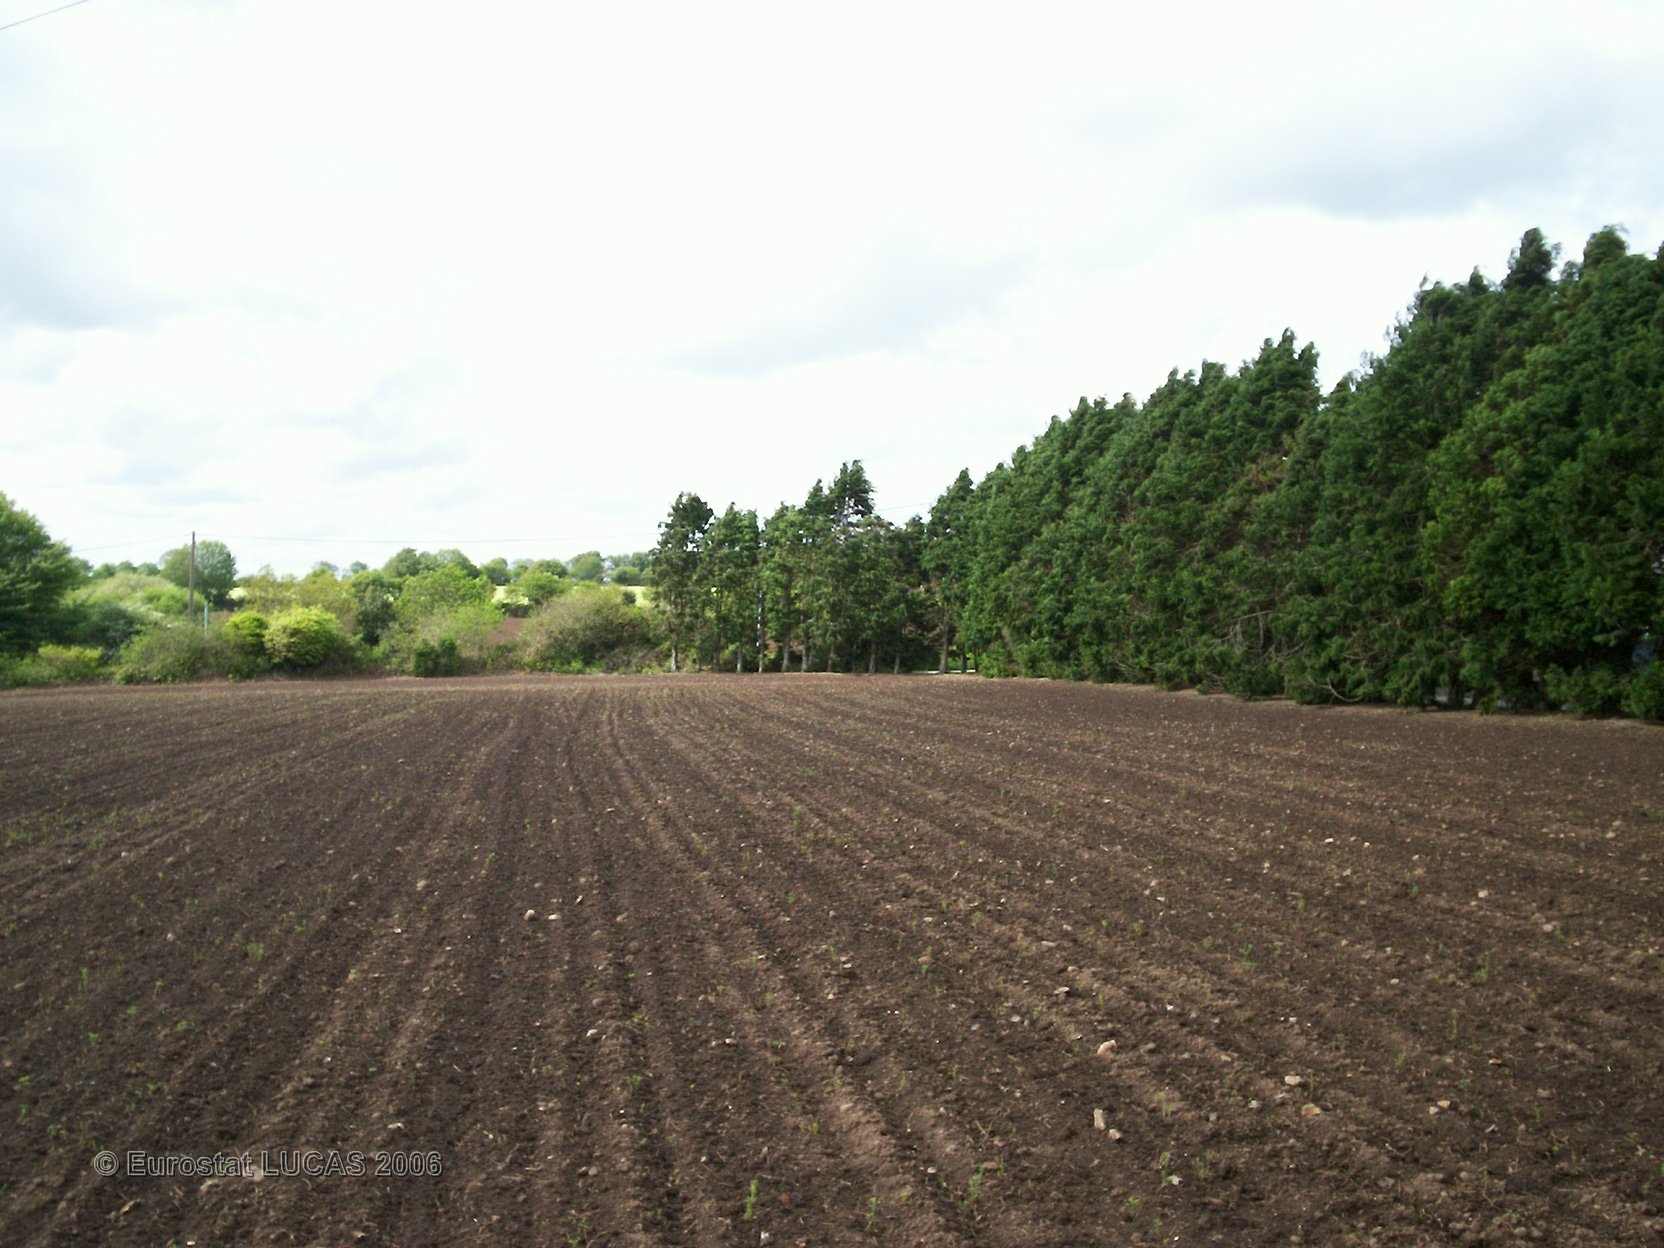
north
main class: Cropland
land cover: Other cereals
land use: Agriculture (excluding fallow land and kitchen gardens)
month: June
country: FR
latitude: 48.0829
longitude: -3.9254
